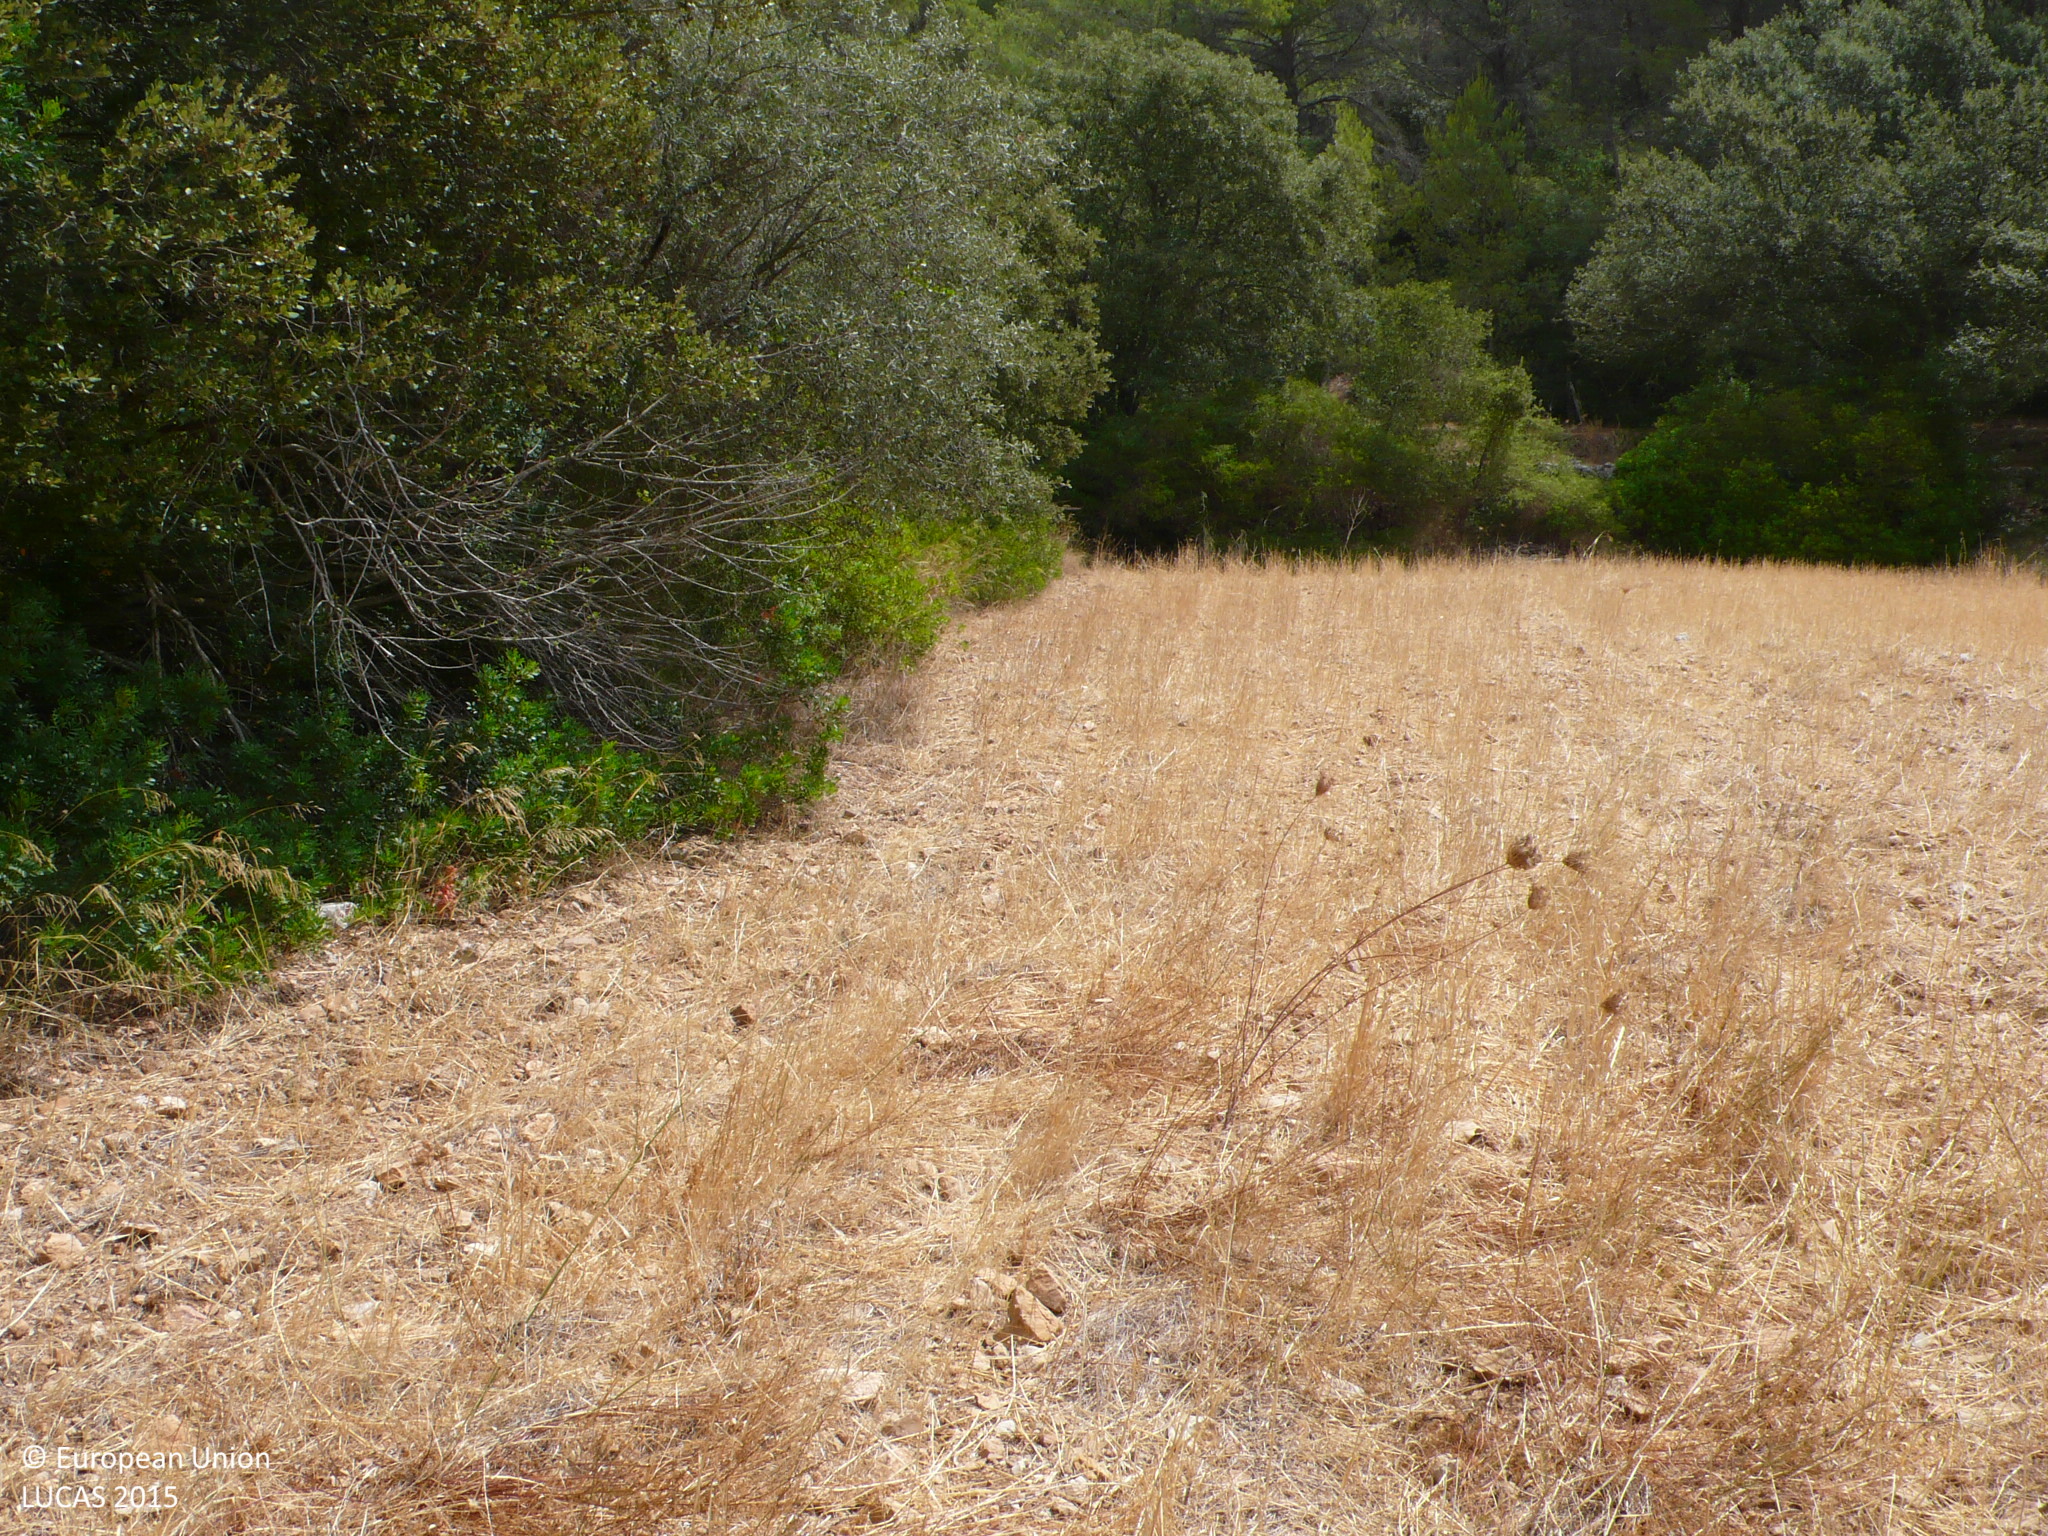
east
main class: Cropland
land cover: Barley
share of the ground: 25 - 50 %
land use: Agriculture (excluding fallow land and kitchen gardens)
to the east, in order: Barley; Broadleaved woodland; Dry stone walls; Tracks; Fences; Broadleaved woodland; Fences; Pine dominated mixed woodland; Tracks; Other mixed woodland
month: August
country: ES
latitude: 39.5944
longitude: 2.4498
